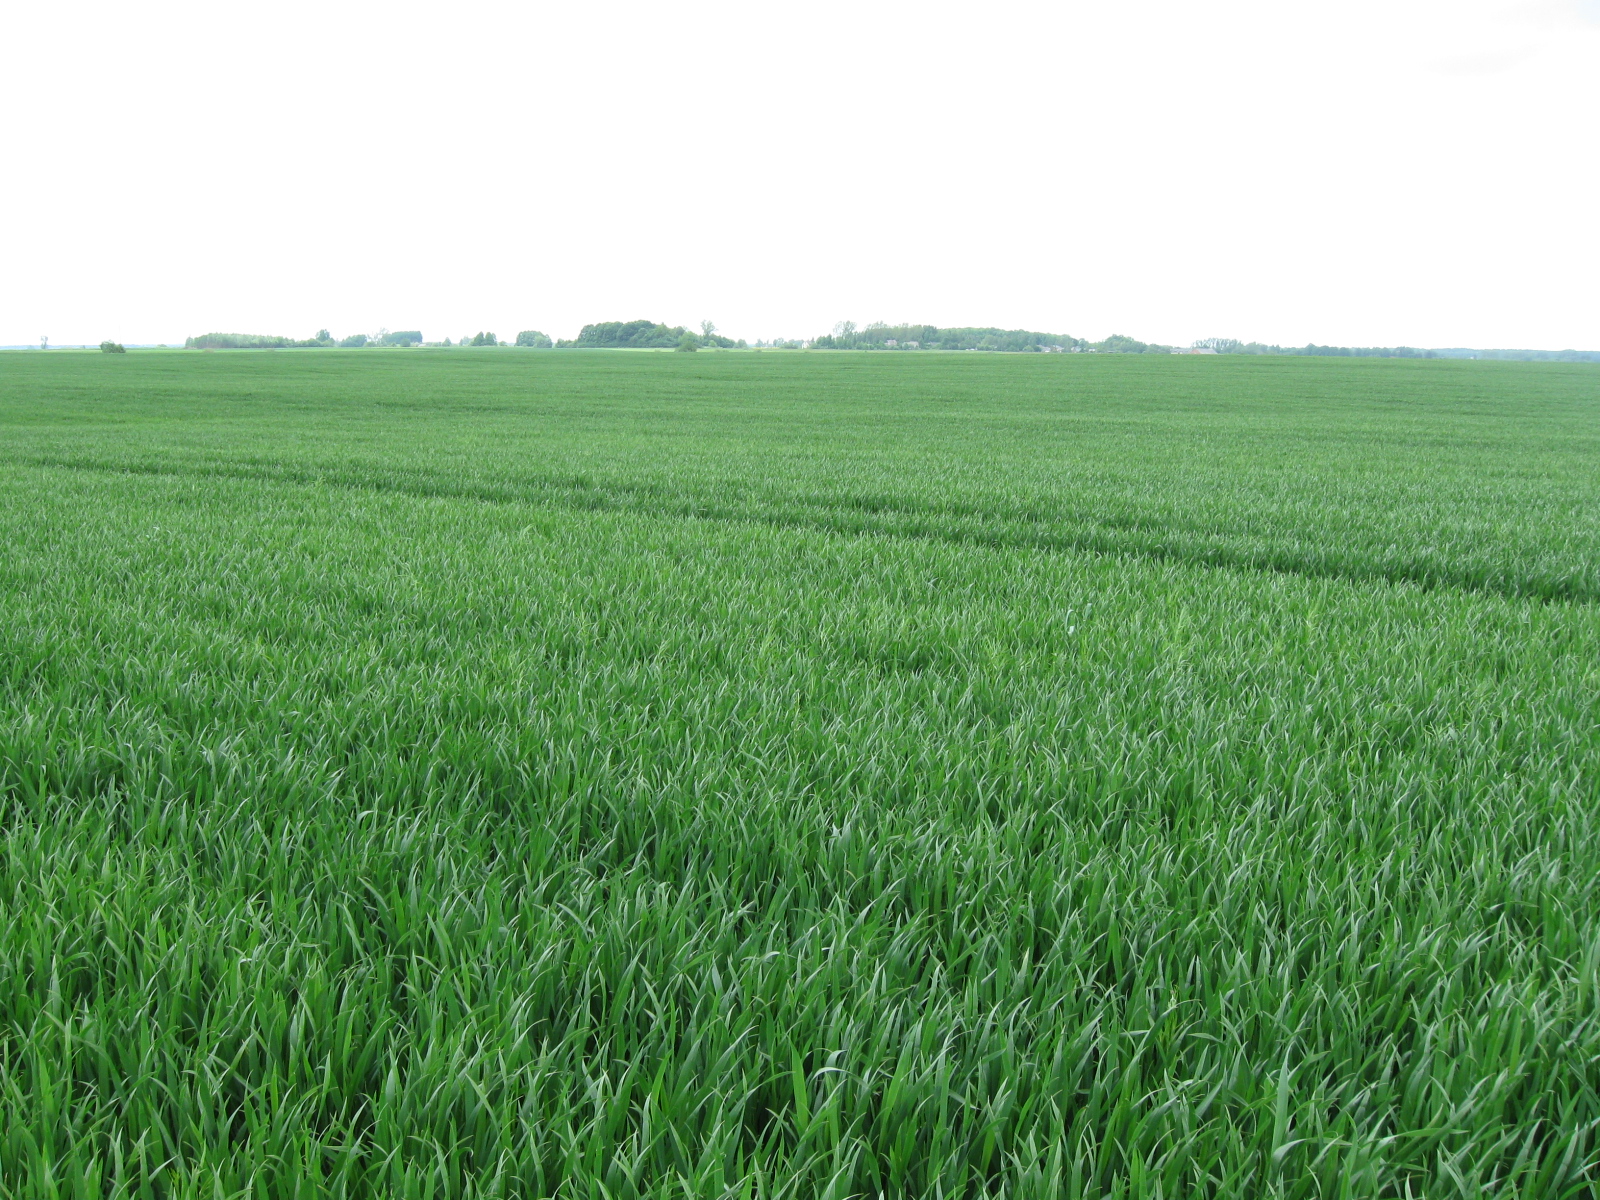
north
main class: Cropland
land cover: Common wheat
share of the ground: > 75 %
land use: Agriculture (excluding fallow land and kitchen gardens)
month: May
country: LT
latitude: 54.6831
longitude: 22.8345
